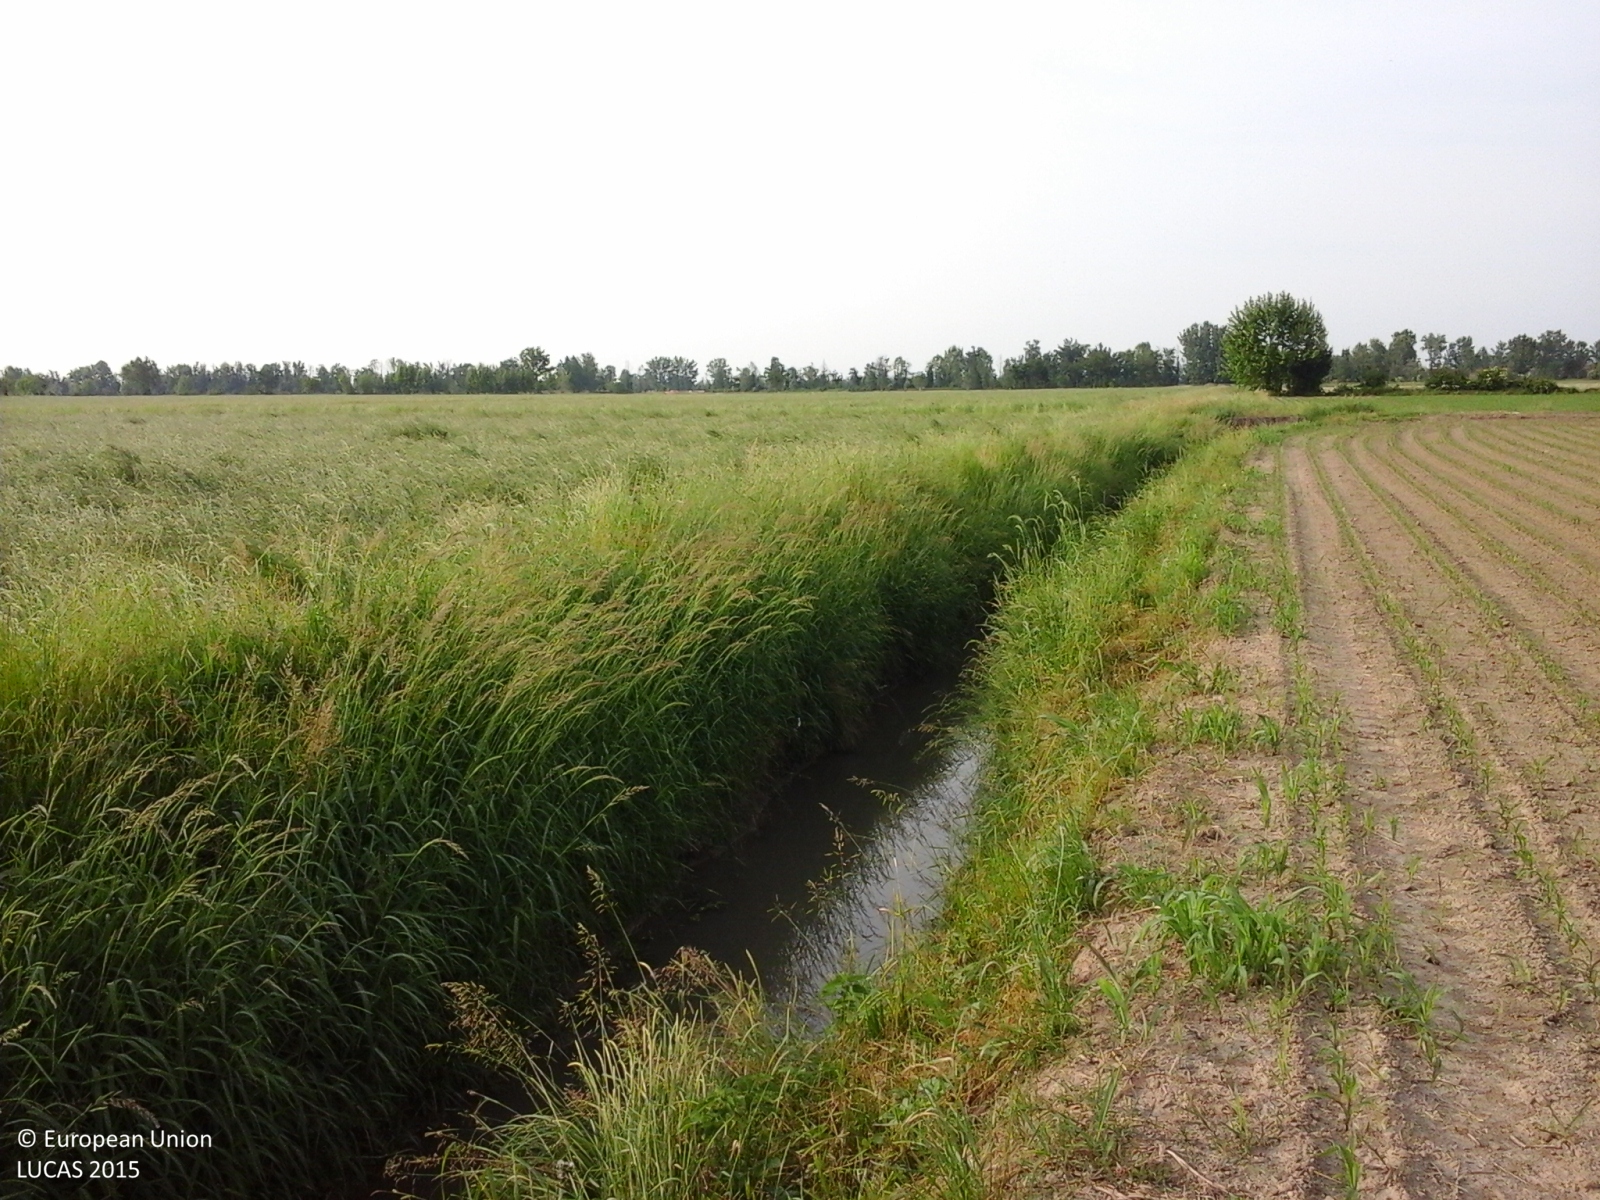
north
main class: Cropland
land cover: Temporary grasslands
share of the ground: > 75 %
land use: Agriculture (excluding fallow land and kitchen gardens)
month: May
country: IT
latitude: 45.2160
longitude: 10.0127
